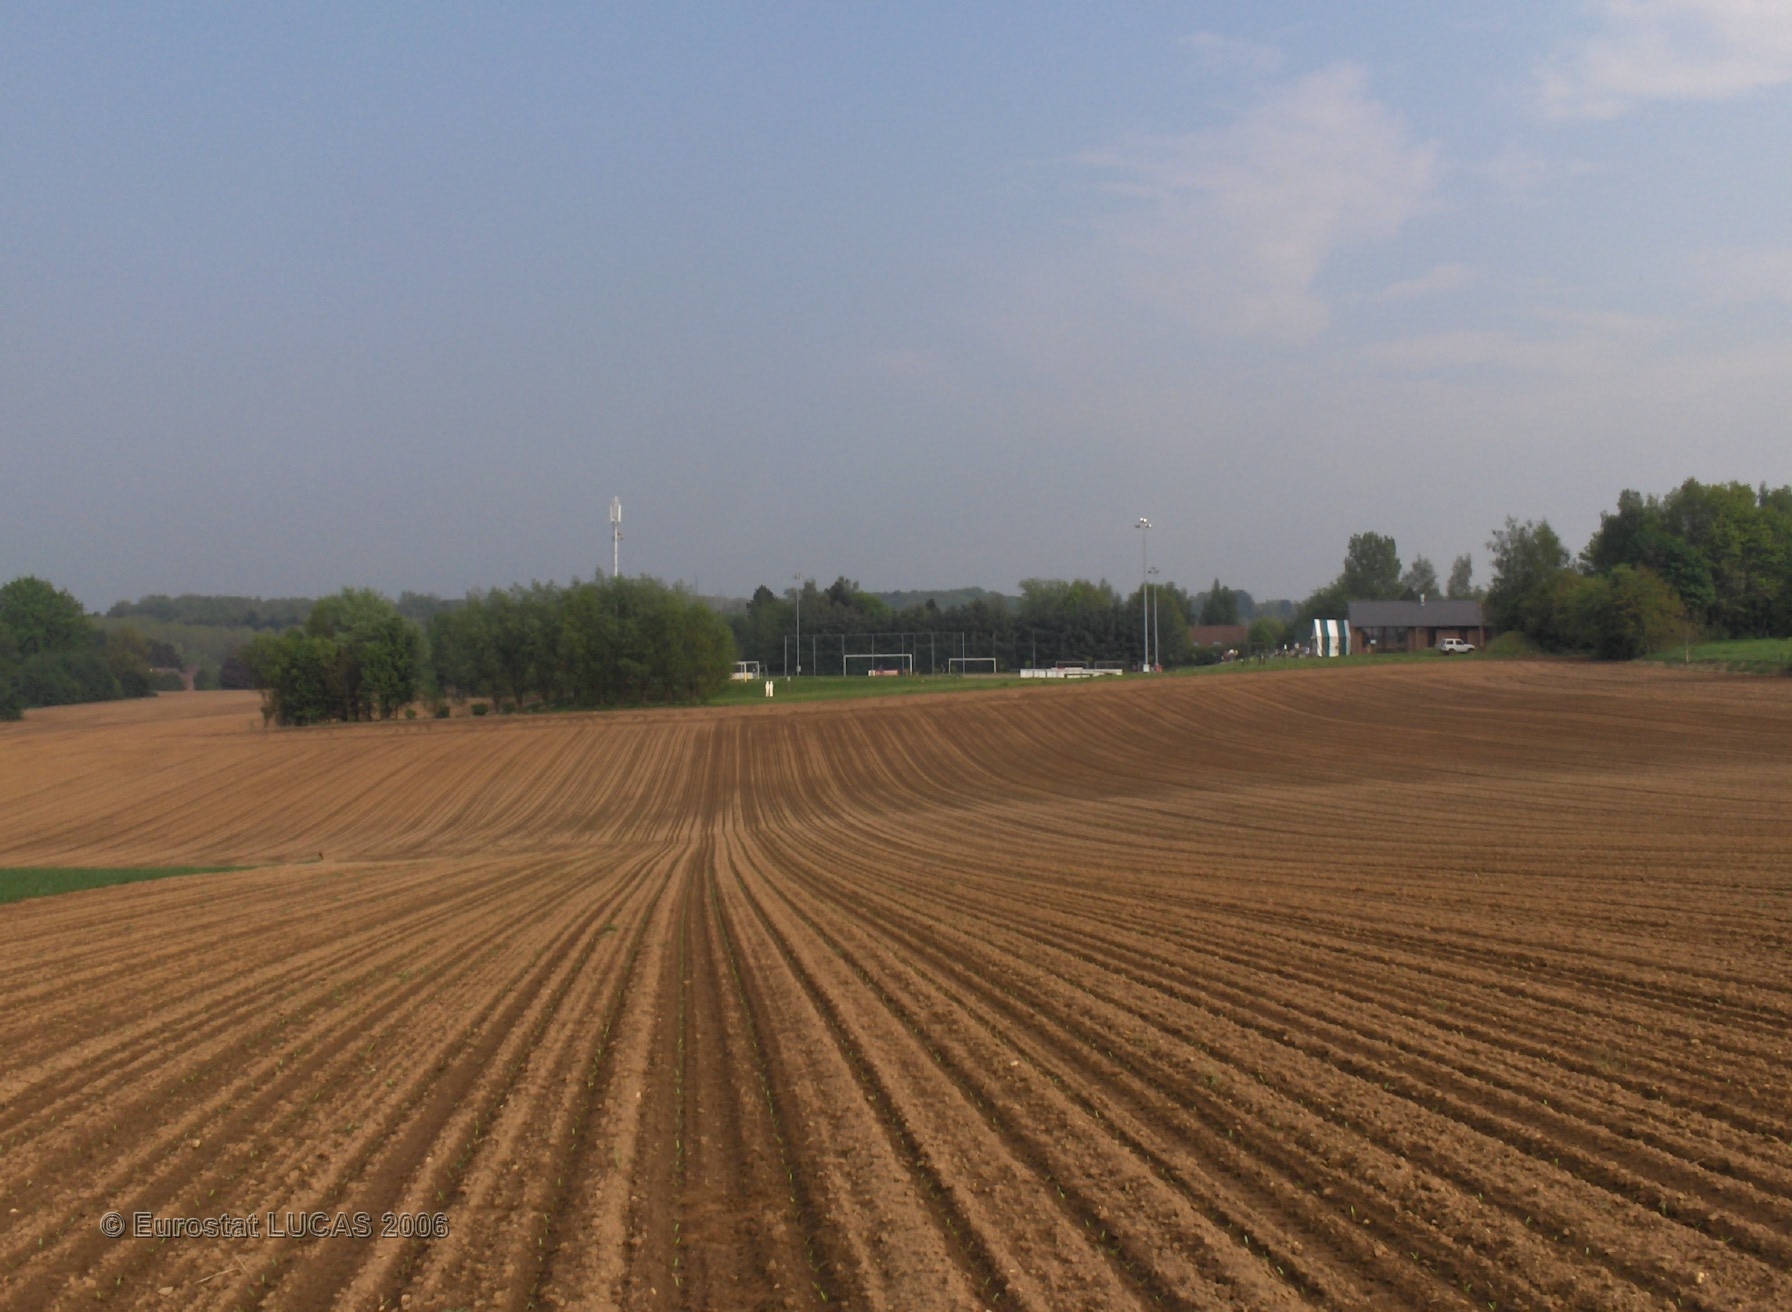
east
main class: Cropland
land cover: Sugar beet
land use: Agriculture (excluding fallow land and kitchen gardens)
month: May
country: BE
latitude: 50.6626
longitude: 4.4642
